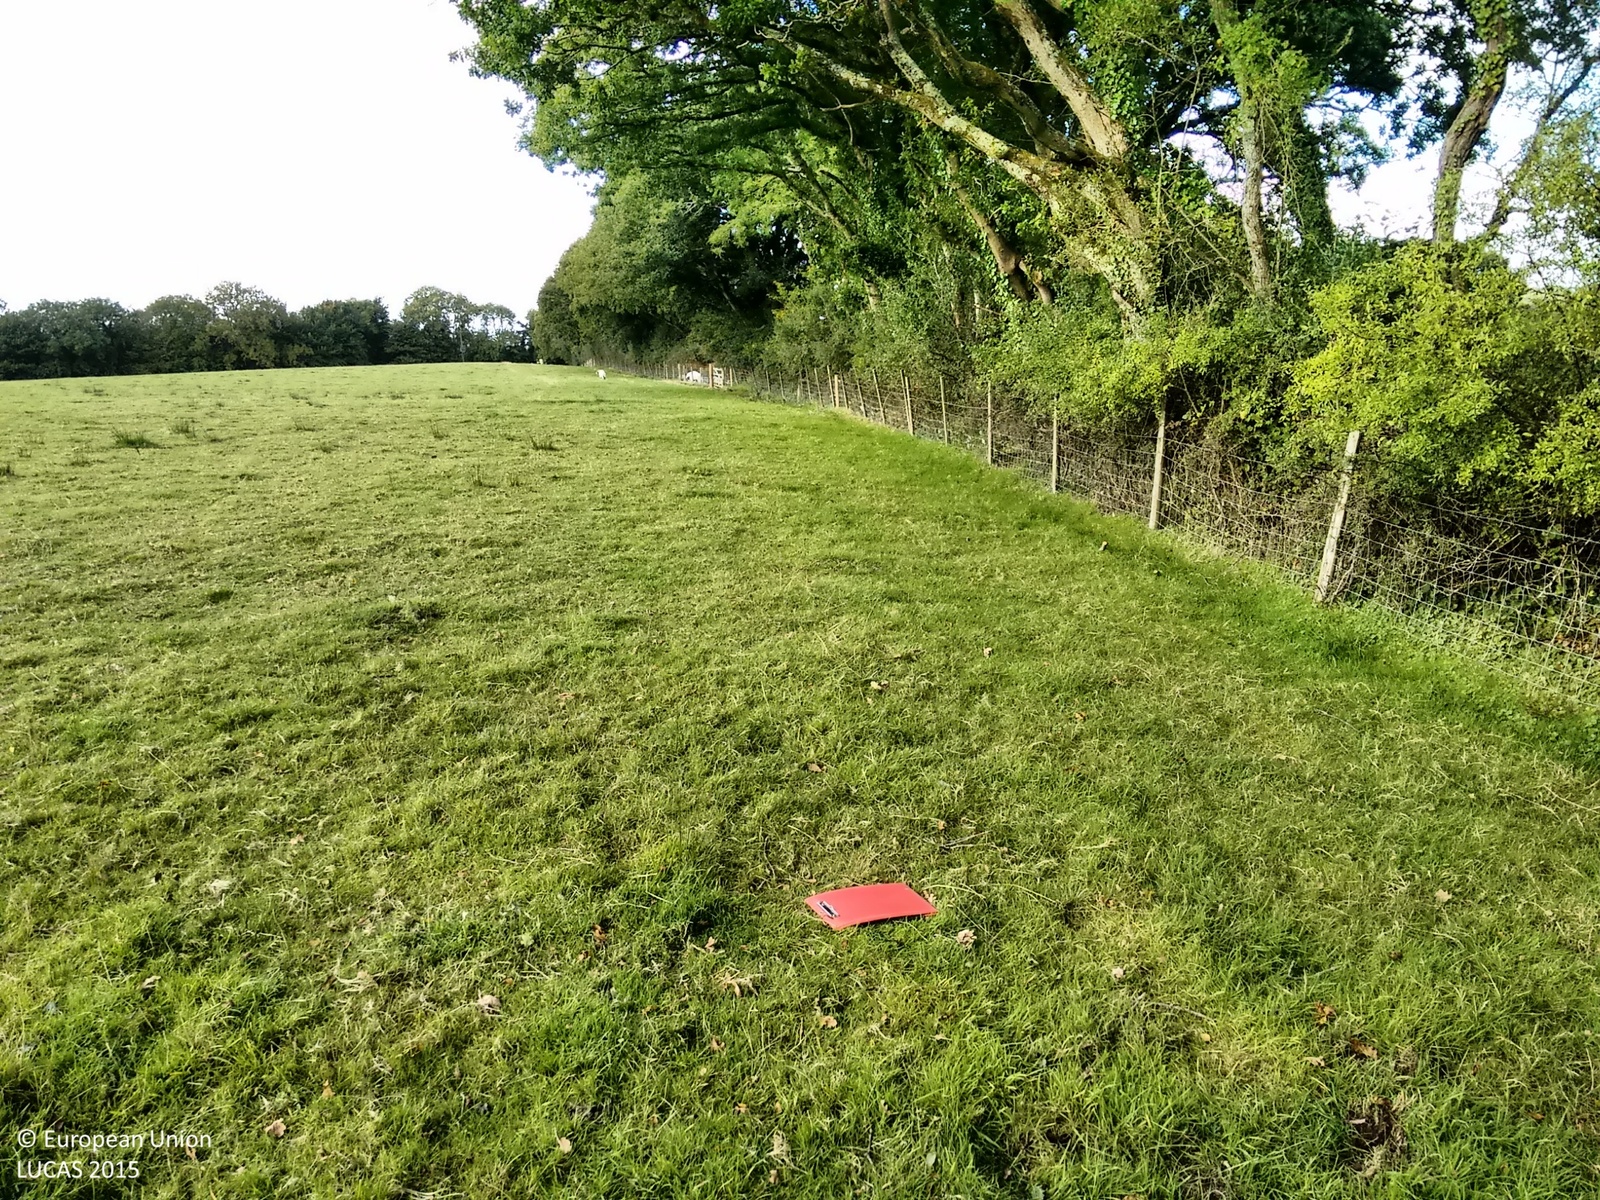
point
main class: Grassland
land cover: Grassland without tree/shrub cover
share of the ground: > 75 %
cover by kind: herbaceous plants 100 %
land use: Agriculture (excluding fallow land and kitchen gardens)
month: September
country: GB
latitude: 50.8383
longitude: -4.0831
